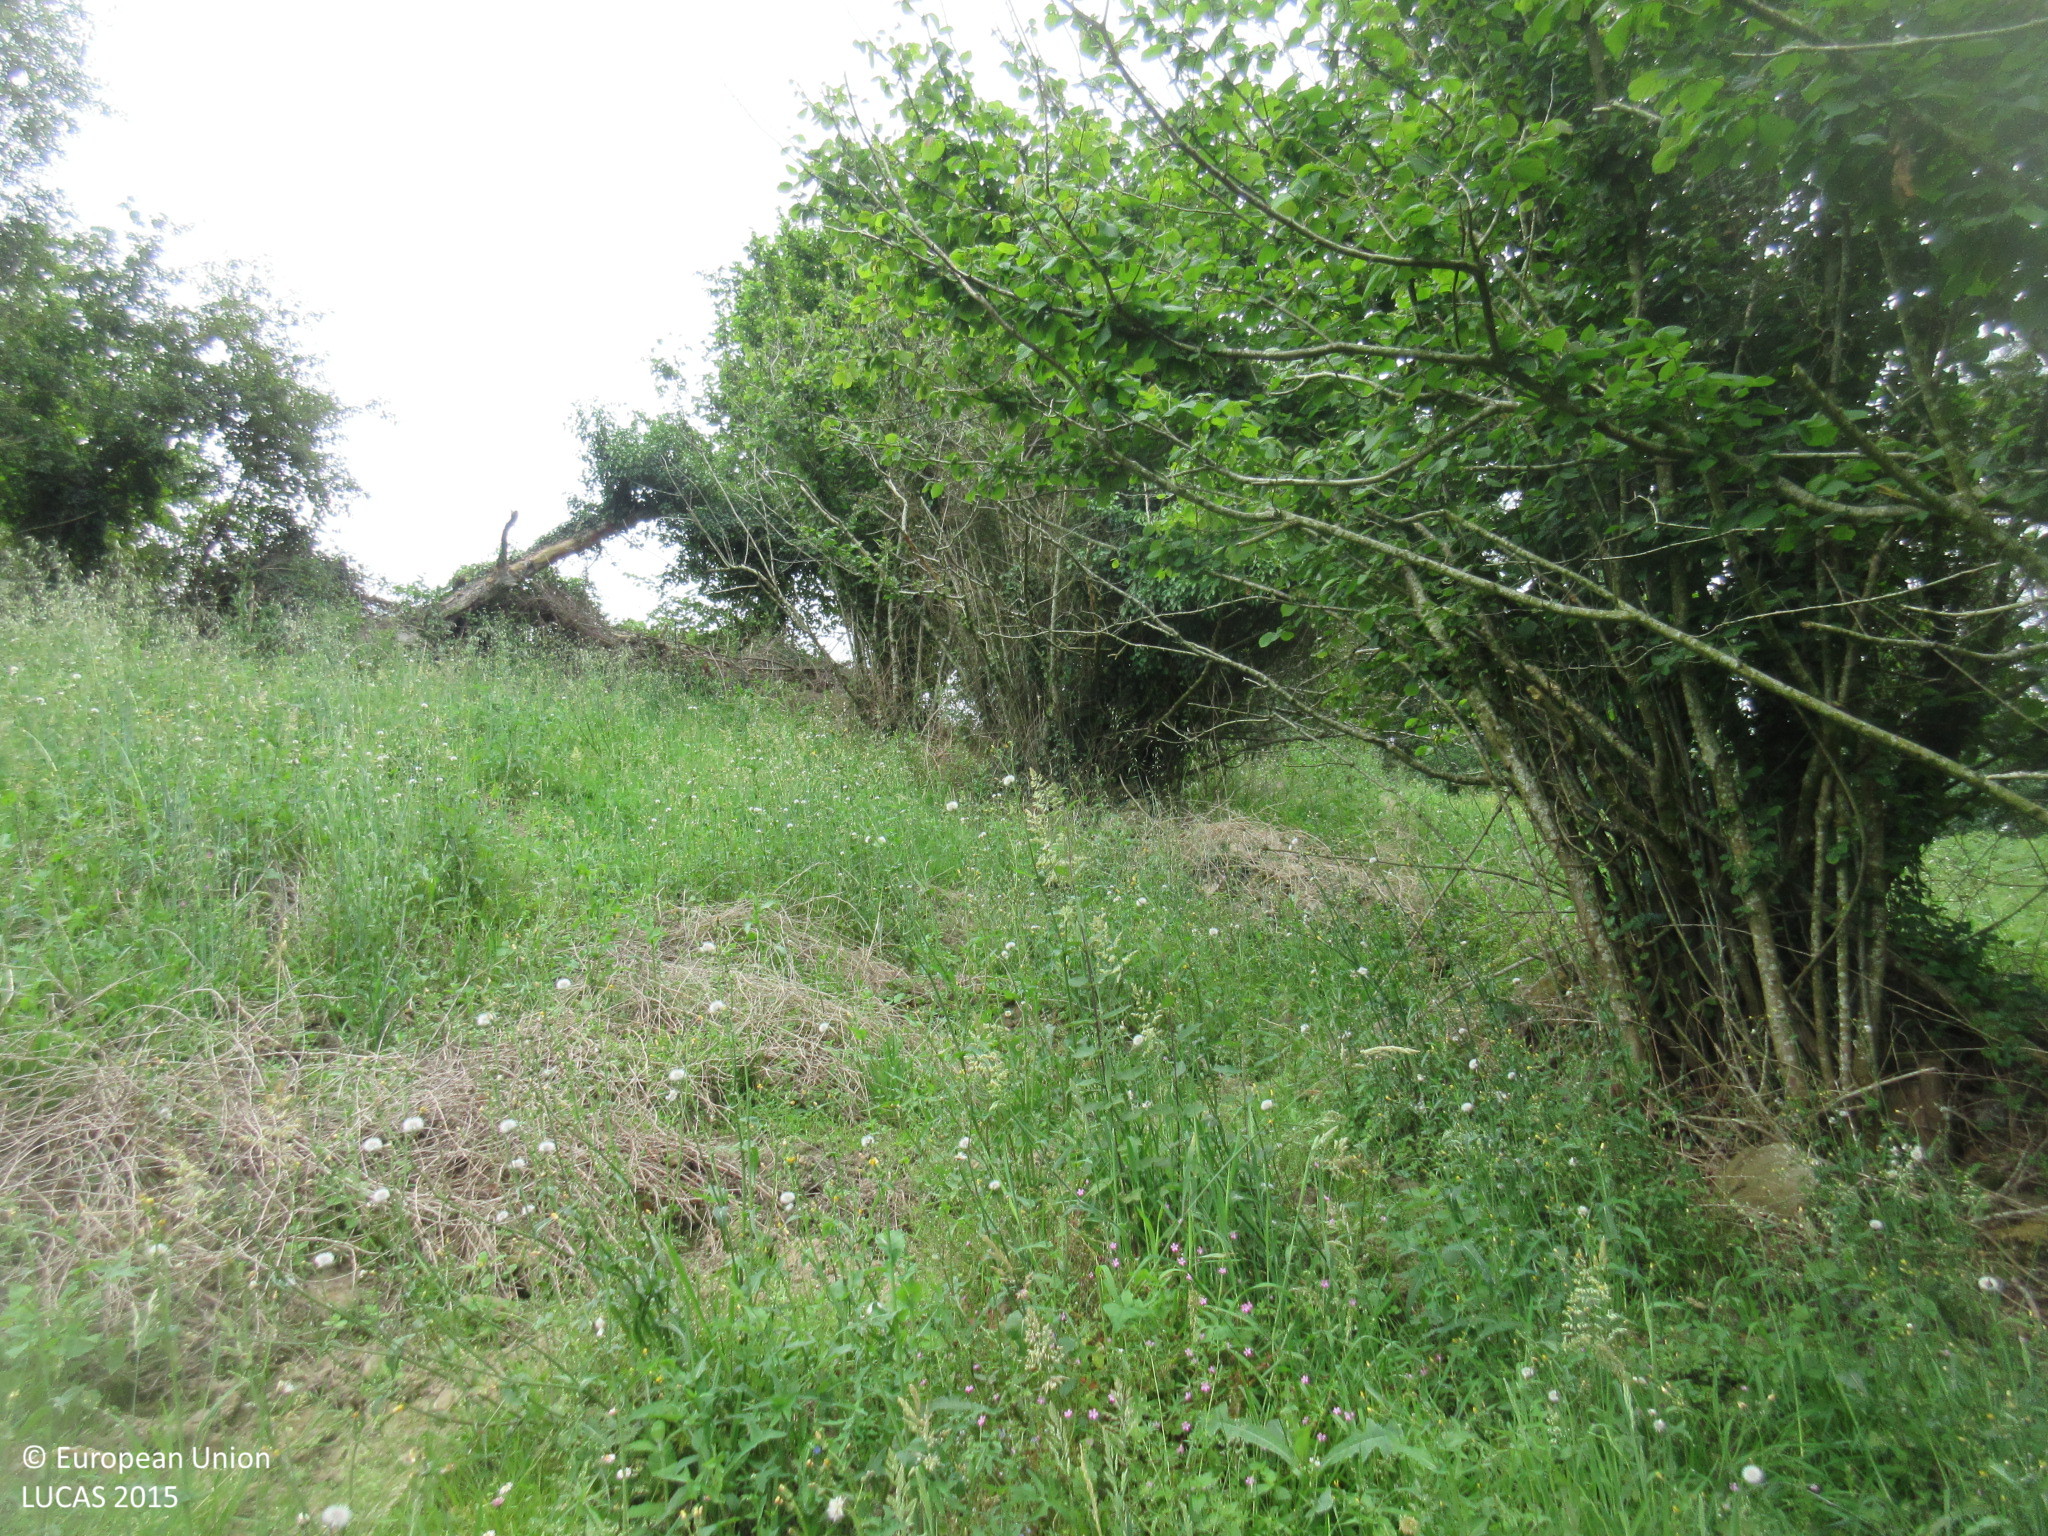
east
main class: Grassland
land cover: Grassland without tree/shrub cover
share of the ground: > 75 %
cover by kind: herbaceous plants 100 %
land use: Agriculture (excluding fallow land and kitchen gardens)
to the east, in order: Grassland without tree/shrub cover; Dry stone walls; Broadleaved woodland; Fences; Broadleaved woodland; Grassland without tree/shrub cover; Broadleaved woodland; Dry stone walls; Grassland without tree/shrub cover
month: June
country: ES
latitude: 43.3583
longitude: -3.6052
